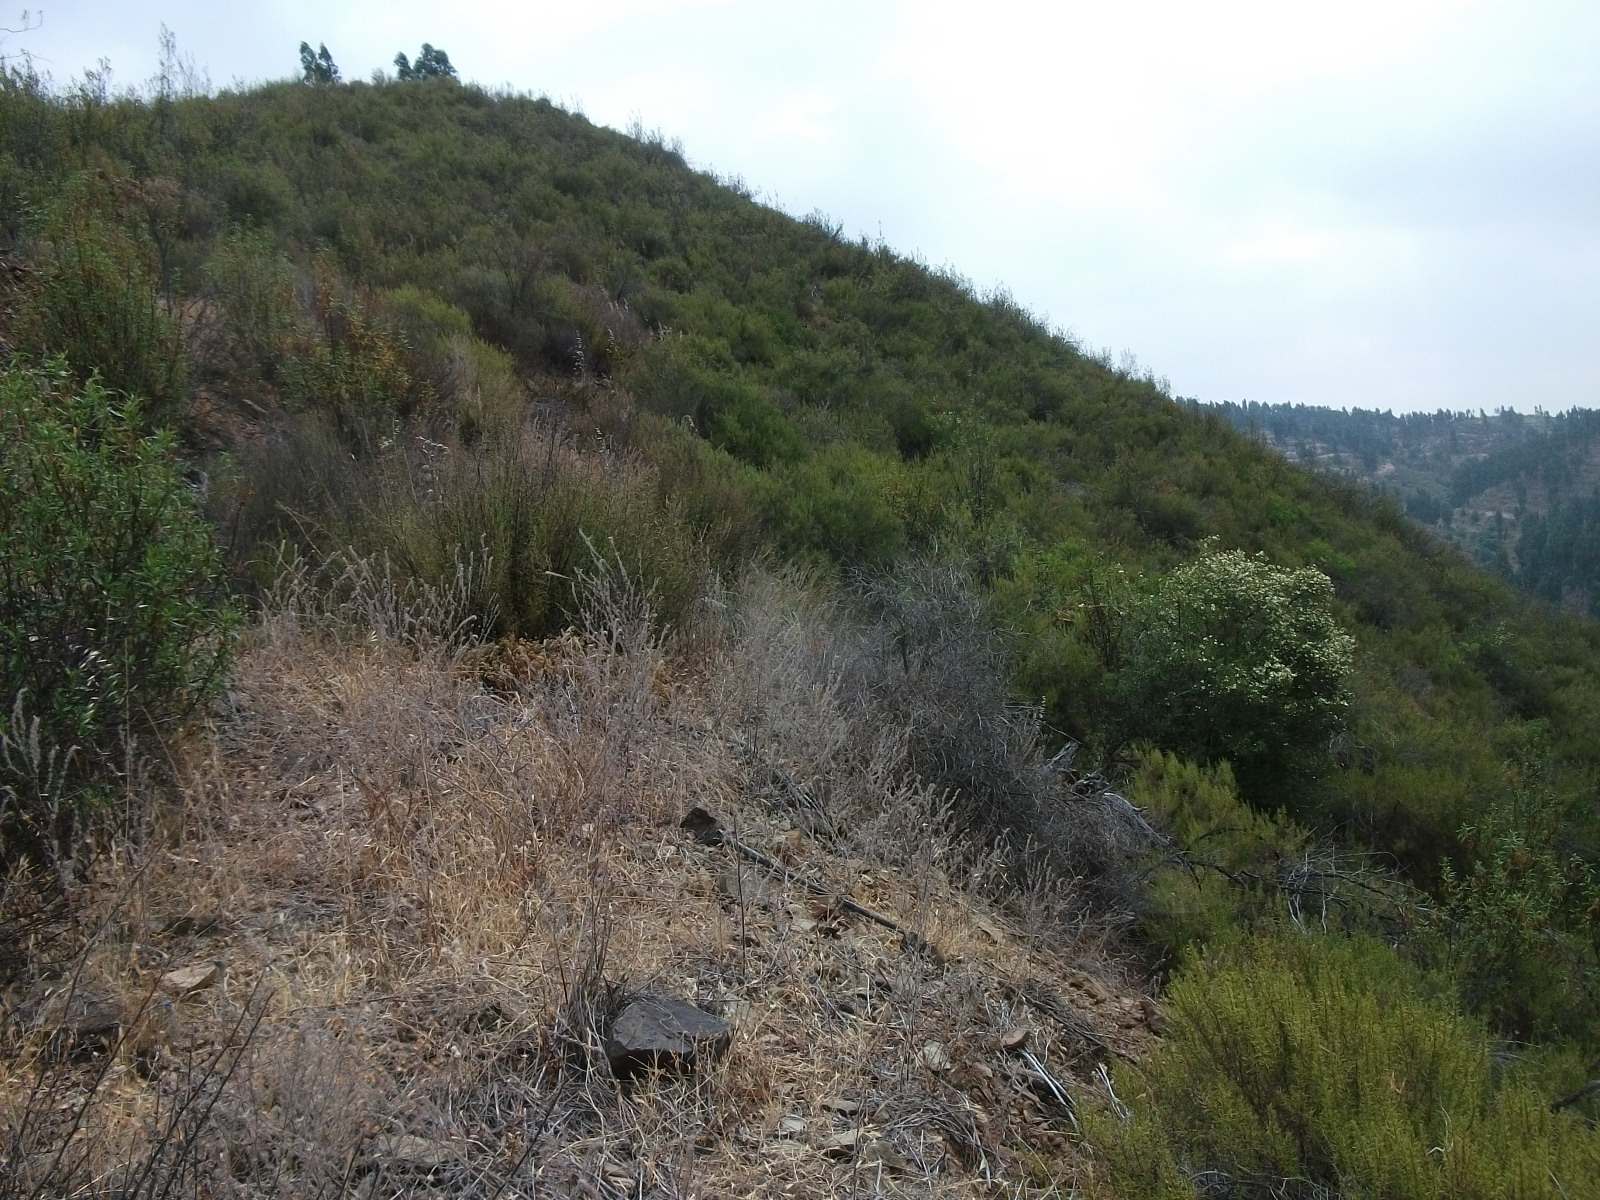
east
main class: Woodland
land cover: Broadleaved woodland
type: exotic forest
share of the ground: 10 - 25 %
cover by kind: shrubs 65 %, broadleaved forest trees 25 %, herbaceous plants 10 %
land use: Forestry
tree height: > 5 m
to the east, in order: Broadleaved woodland; Rivers and streams; Broadleaved woodland
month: June
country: ES
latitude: 37.4923
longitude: -6.9290
